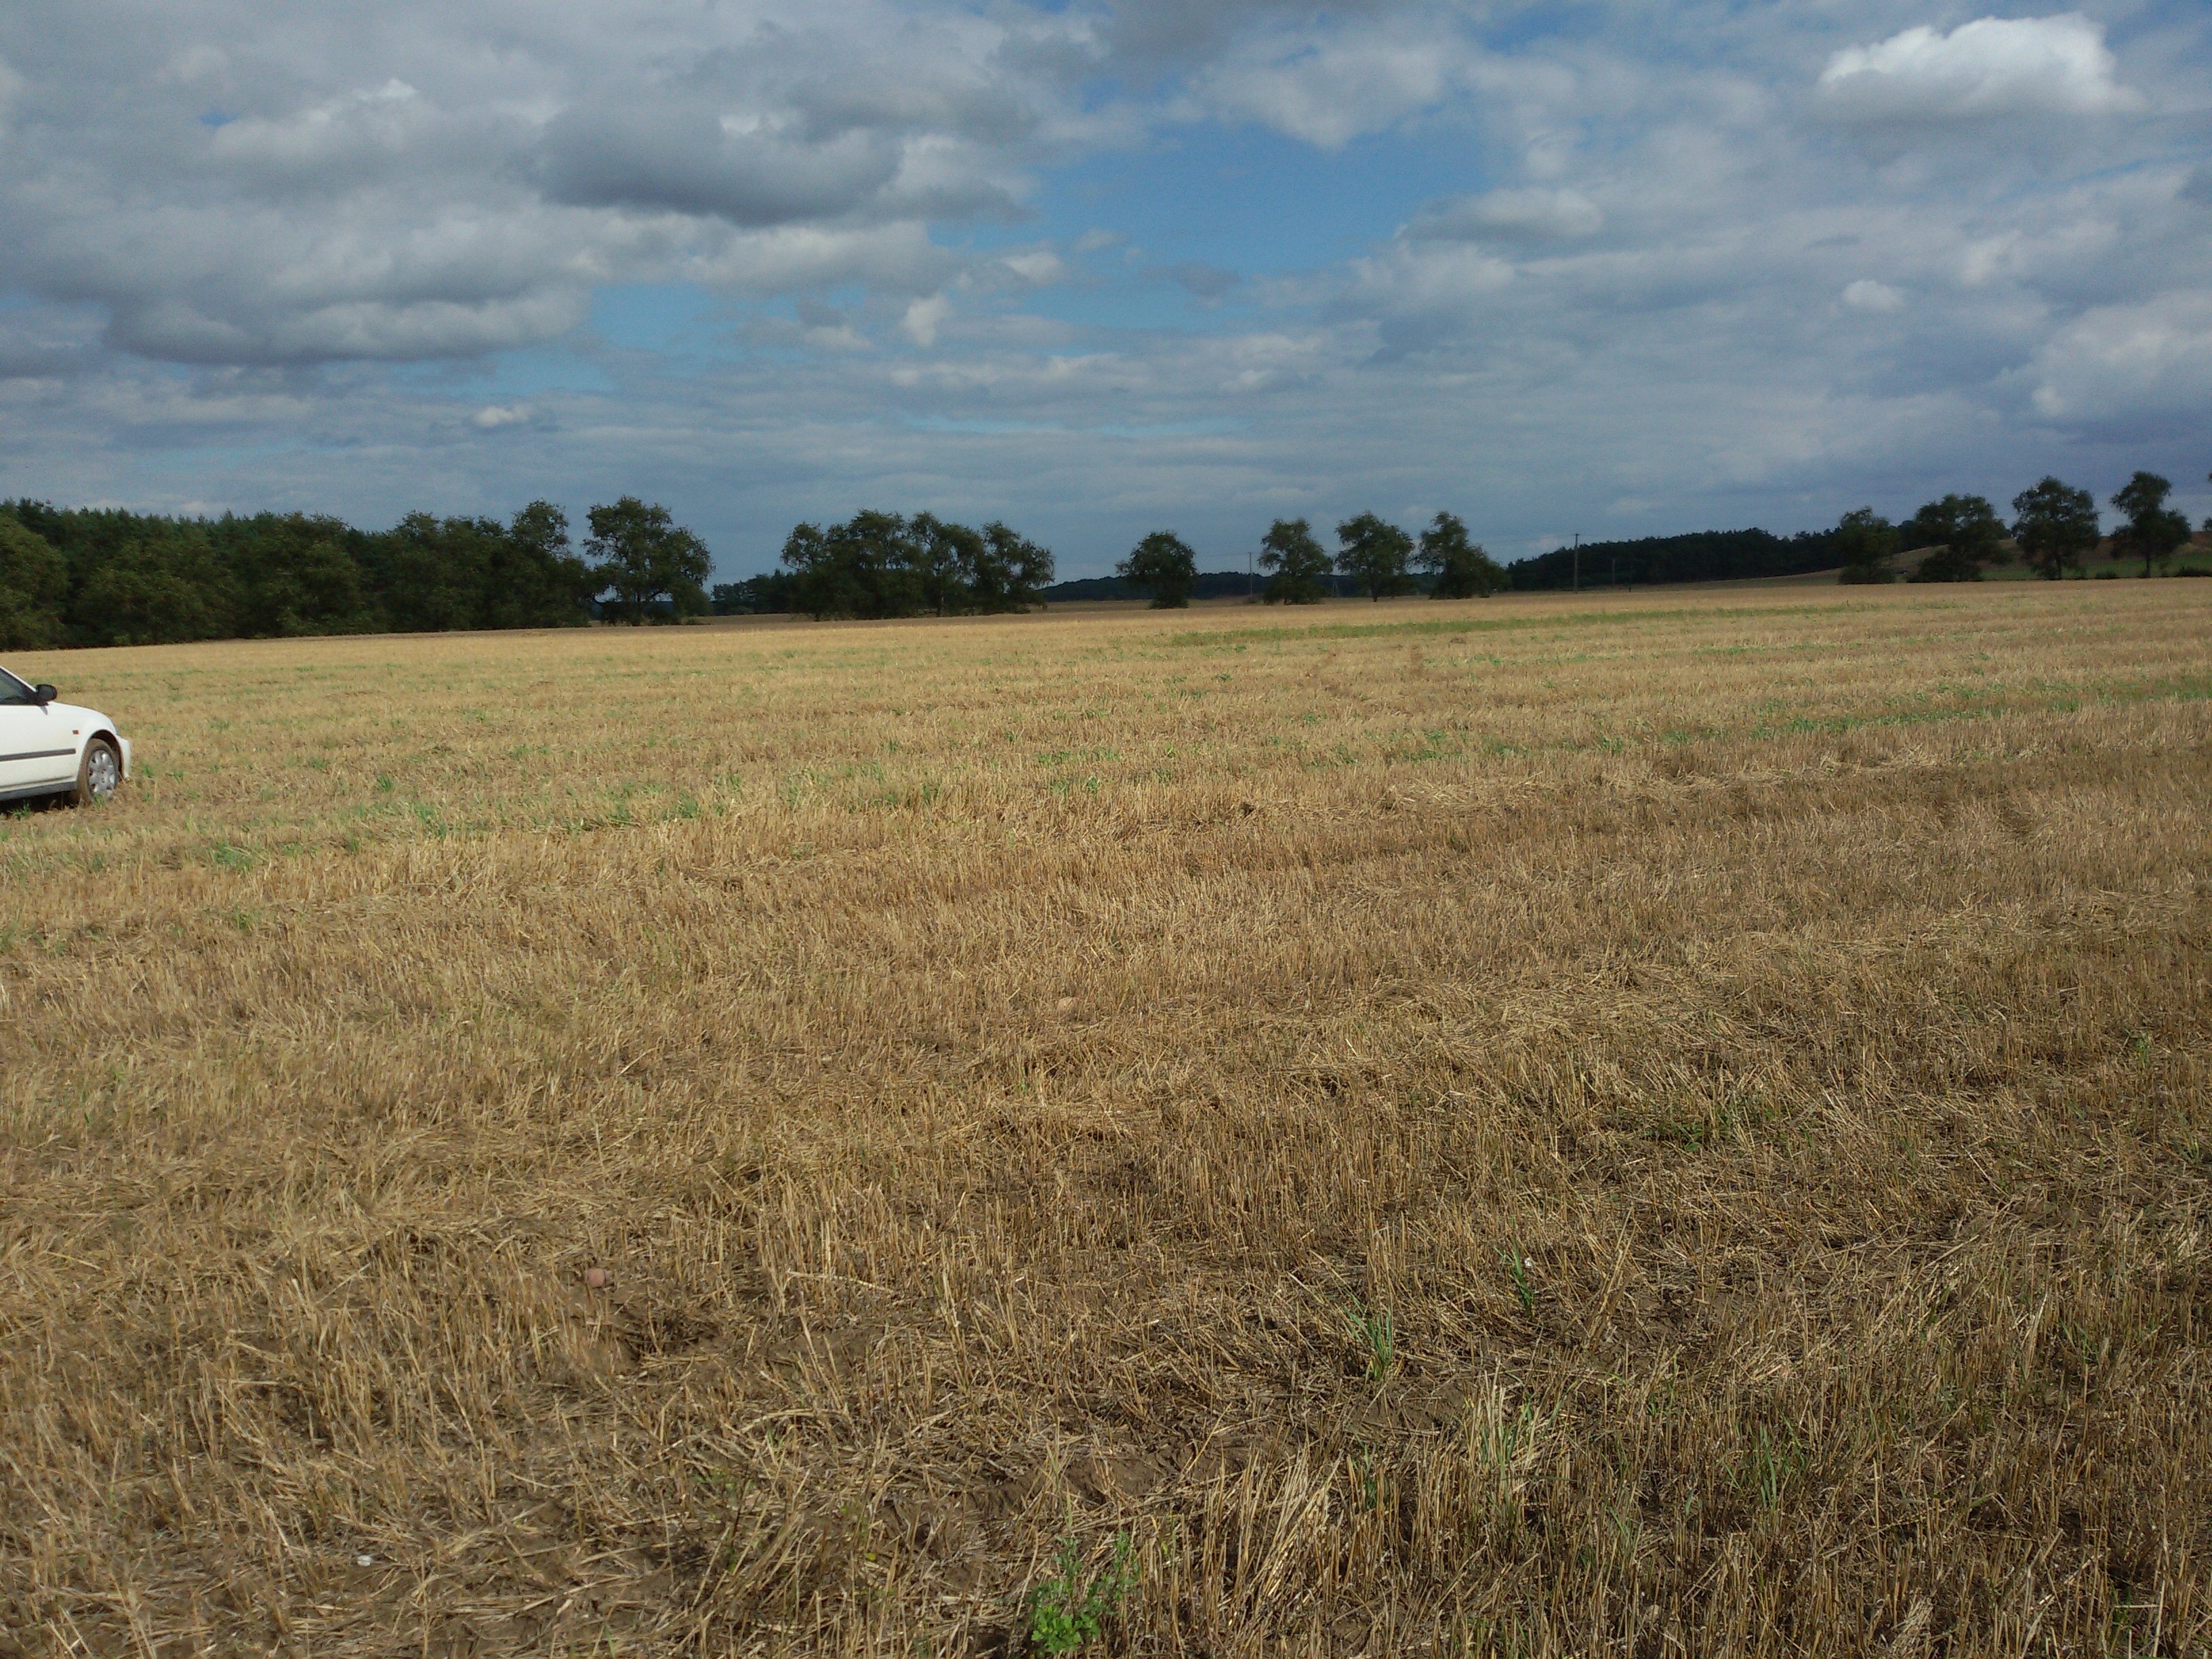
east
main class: Cropland
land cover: Barley
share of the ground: > 75 %
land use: Agriculture (excluding fallow land and kitchen gardens)
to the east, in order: Barley; Lines of trees
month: September
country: PL
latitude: 53.1078
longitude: 17.6161
